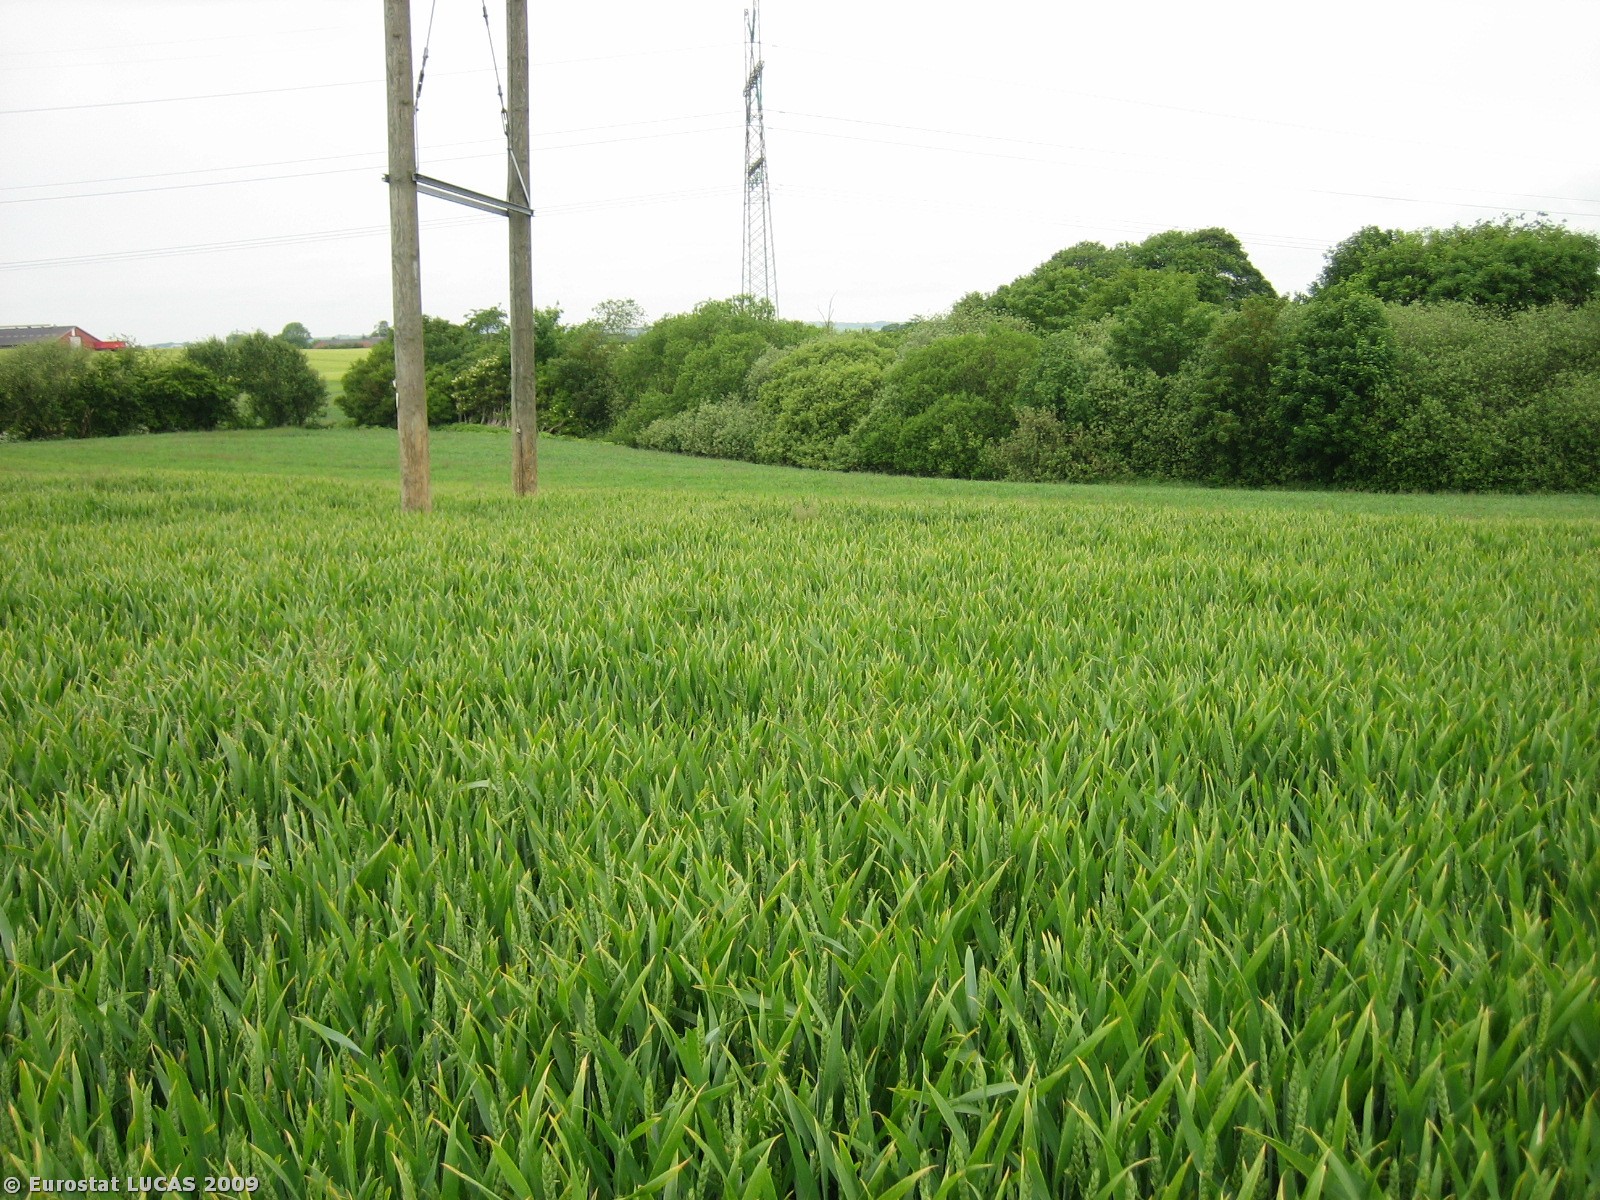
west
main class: Cropland
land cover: Common wheat
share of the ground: > 75 %
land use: Agriculture (excluding fallow land and kitchen gardens)
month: June
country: DK
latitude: 56.0438
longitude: 10.1443
